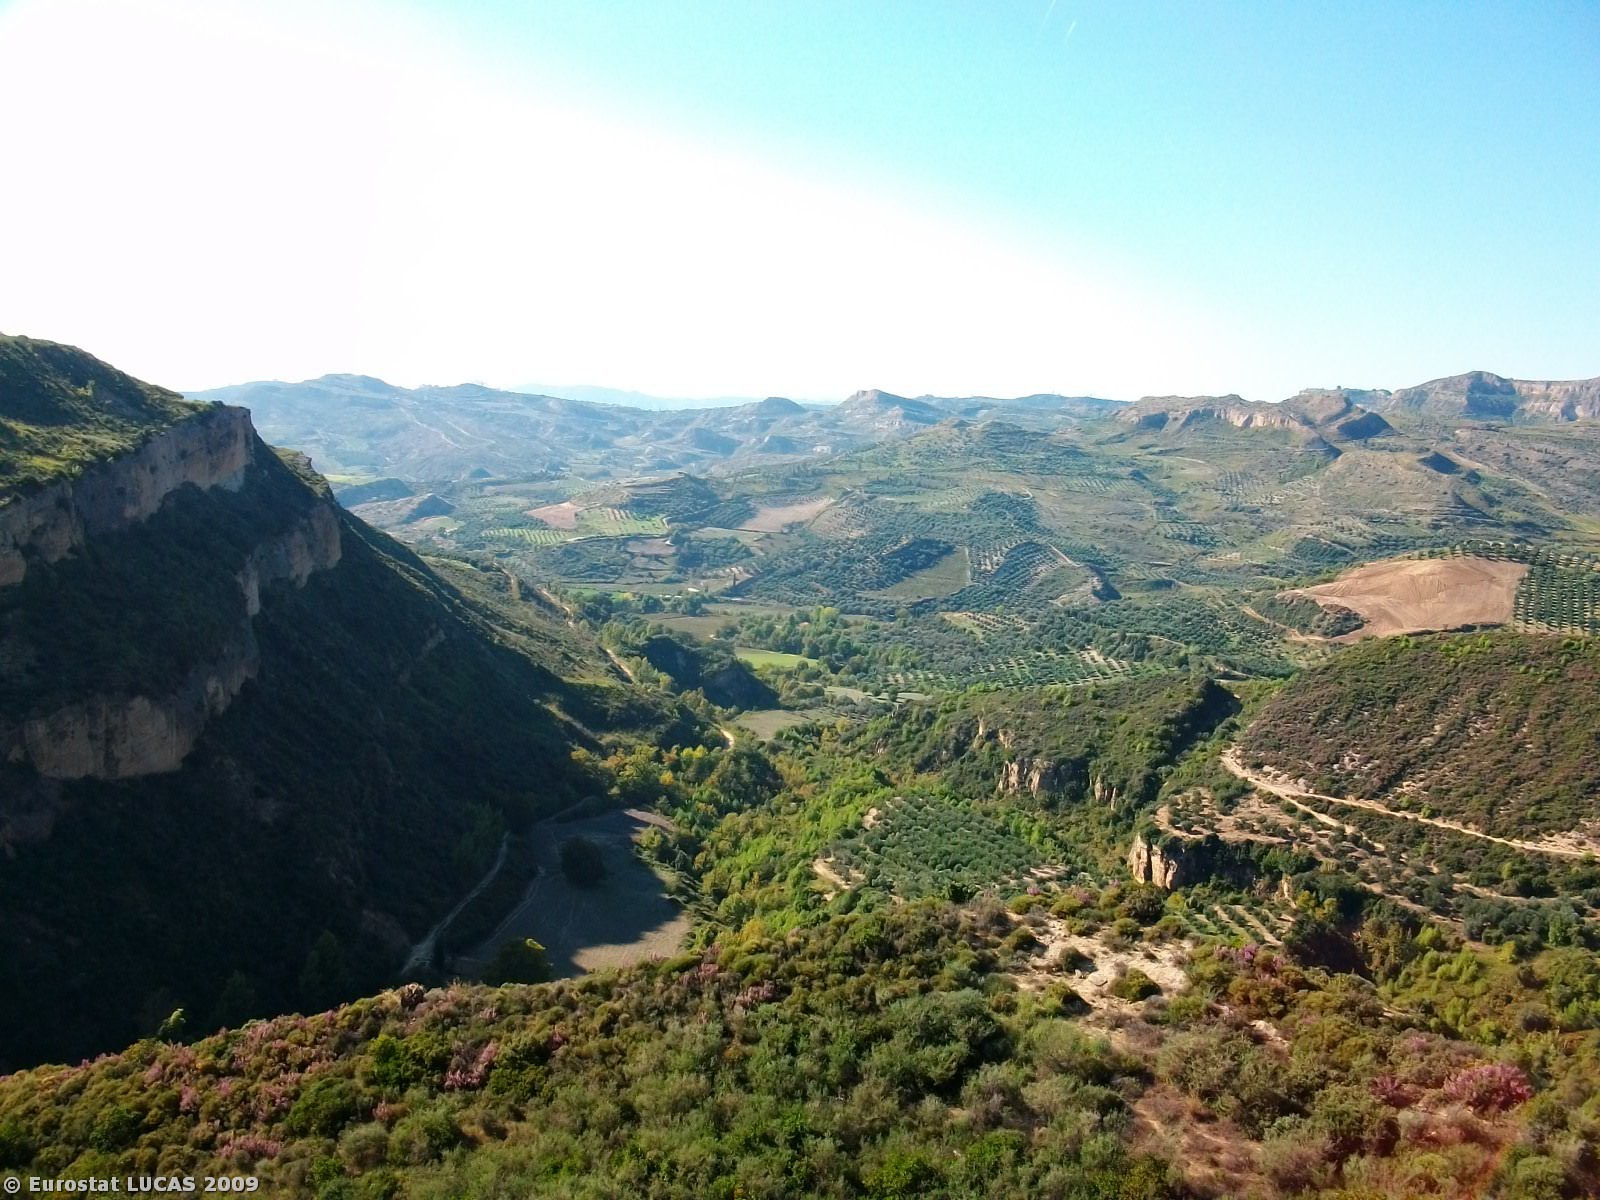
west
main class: Shrubland
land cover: Shrubland without tree cover
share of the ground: > 75 %
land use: Unused
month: October
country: GR
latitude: 37.6849
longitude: 21.6737
